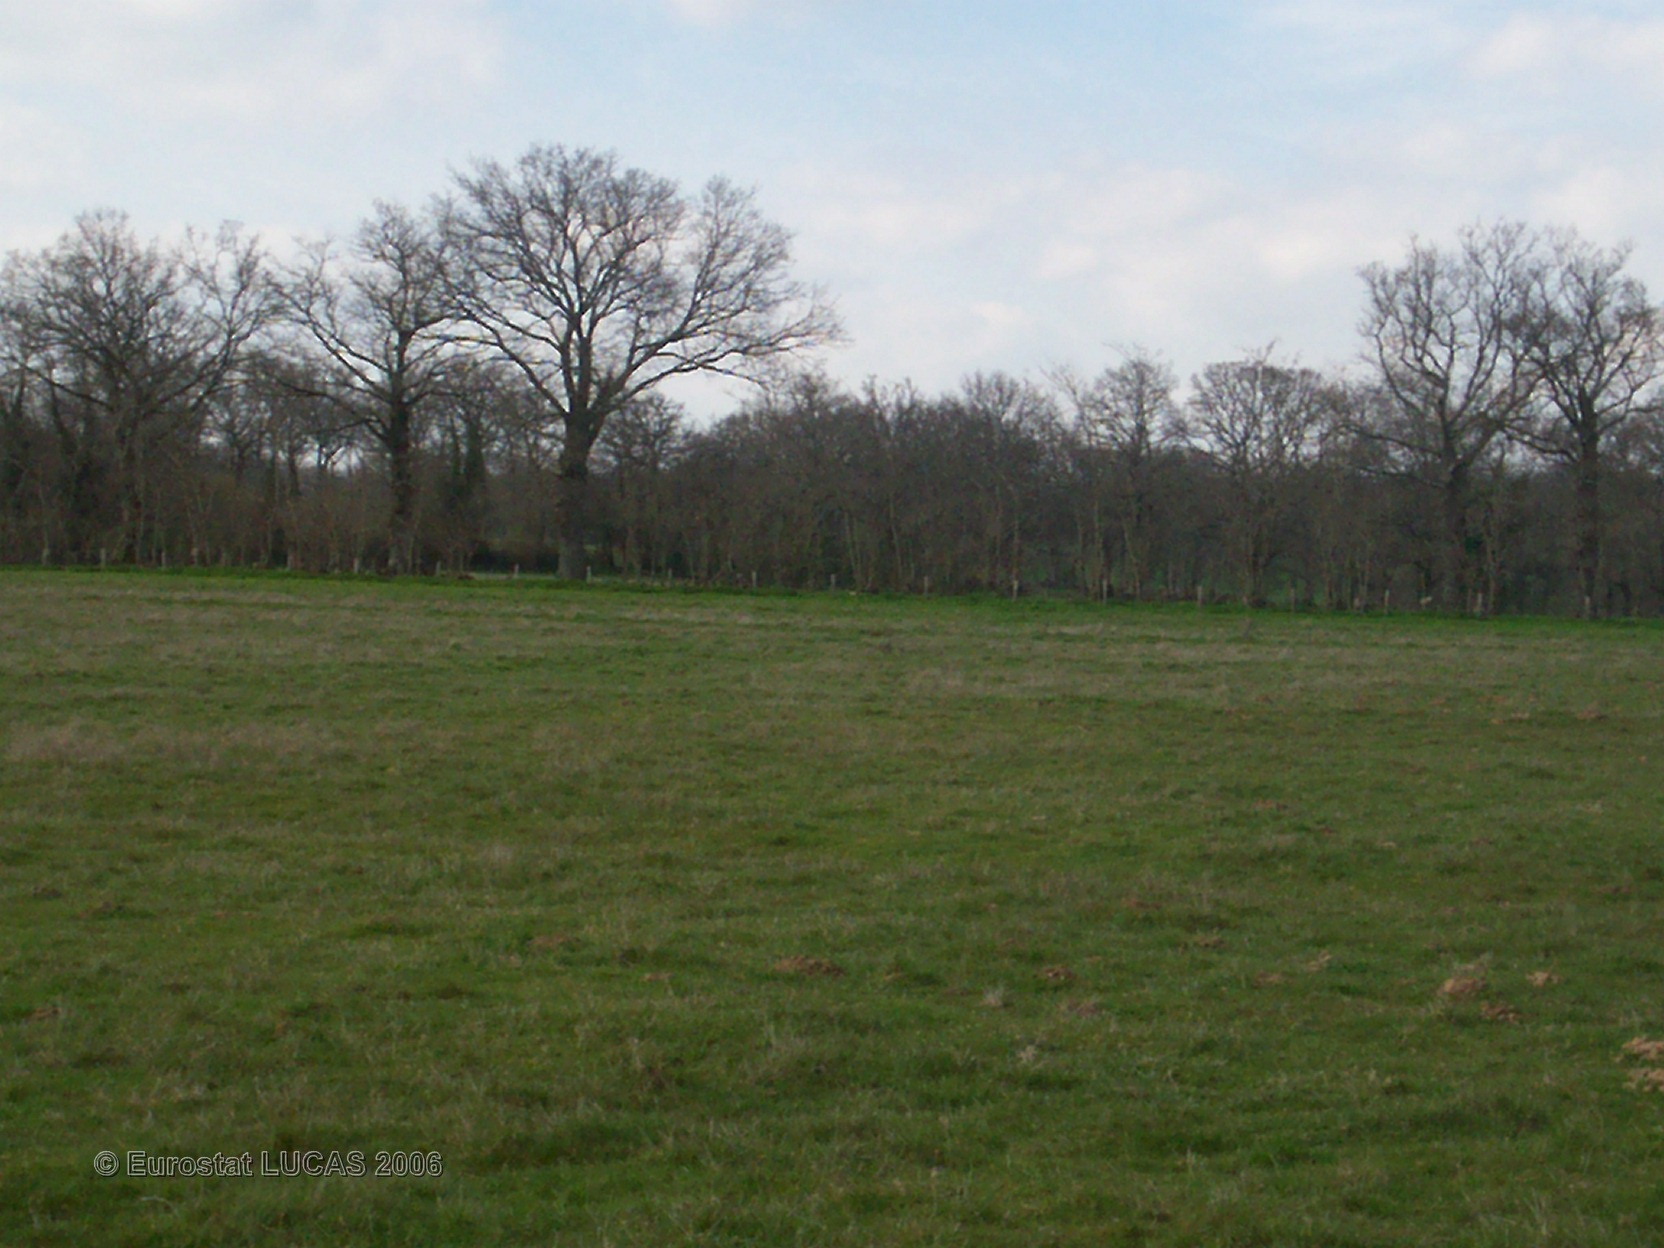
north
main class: Grassland
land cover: Grassland without tree/shrub cover
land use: Agriculture (excluding fallow land and kitchen gardens)
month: April
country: FR
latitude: 46.2516
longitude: 1.1027
